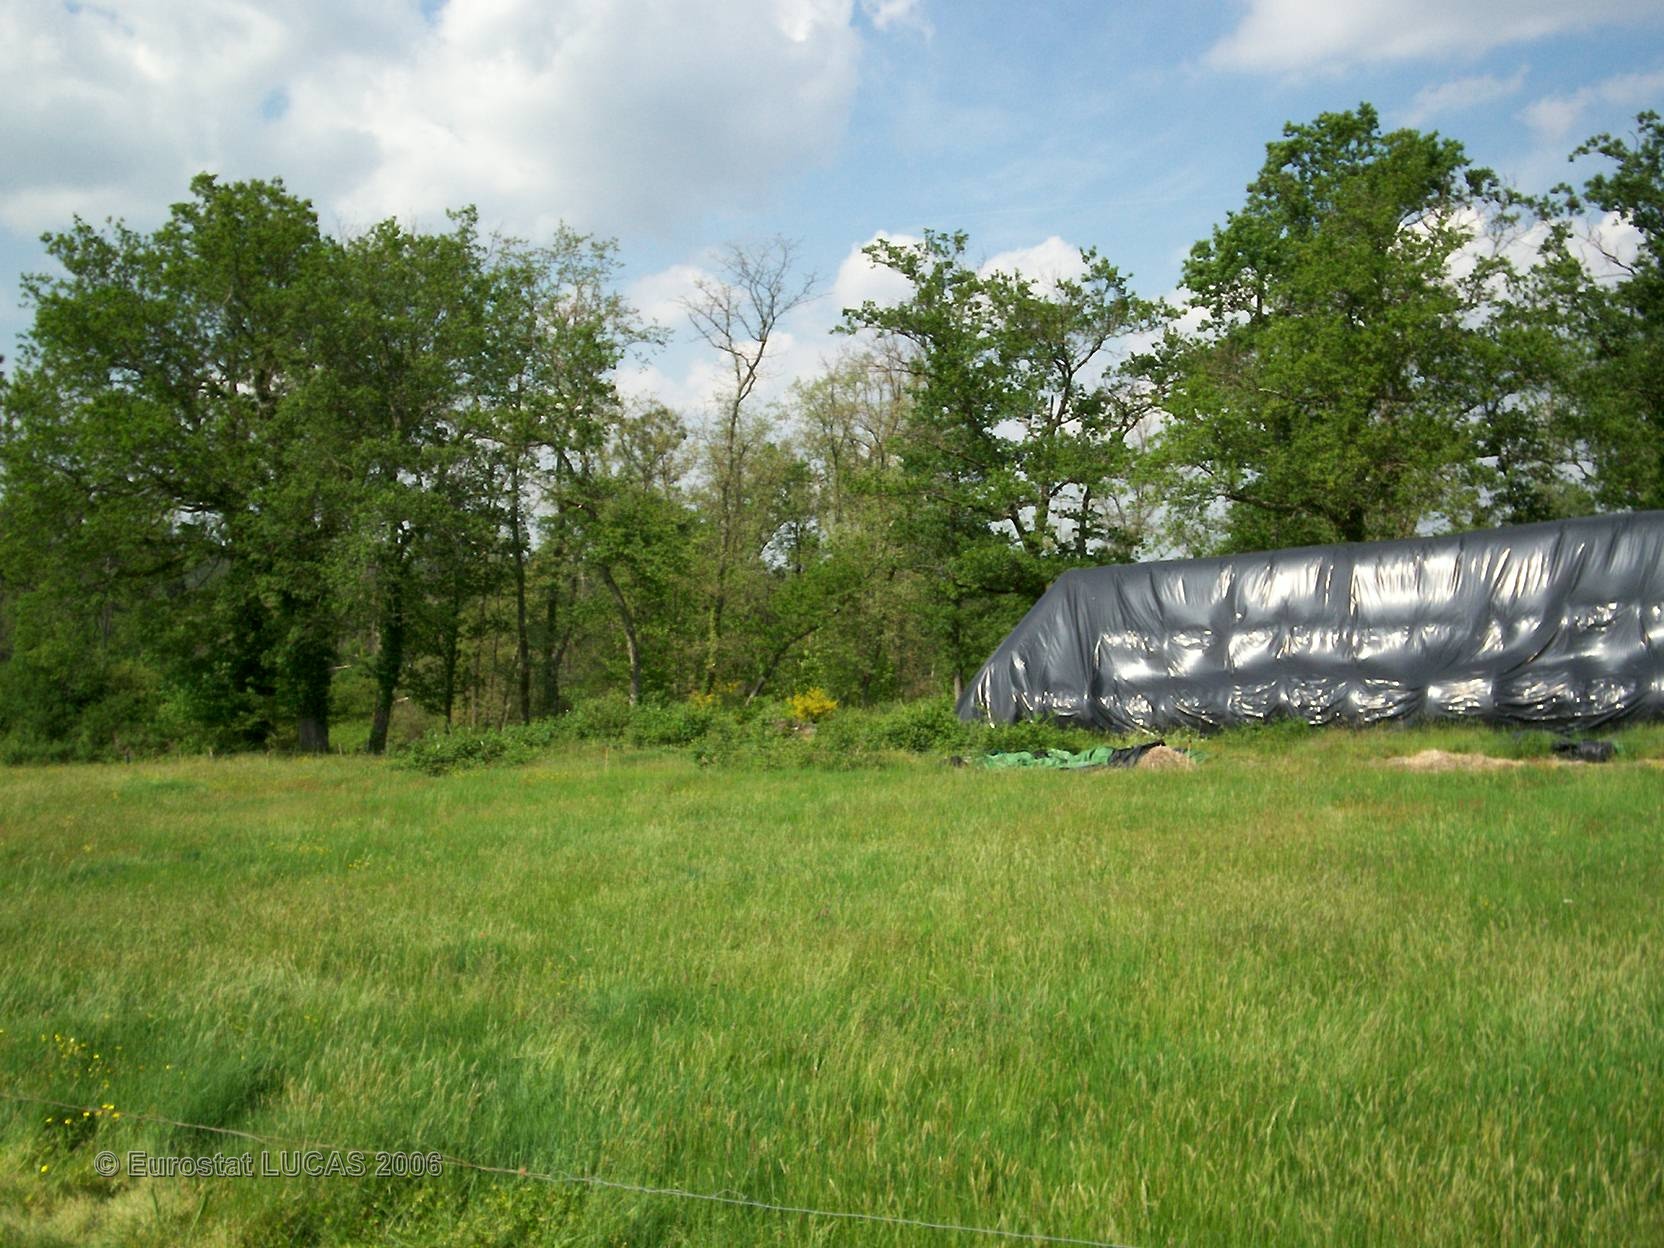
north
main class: Grassland
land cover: Grassland without tree/shrub cover
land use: Agriculture (excluding fallow land and kitchen gardens)
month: May
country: FR
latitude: 45.1304
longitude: -0.0730
